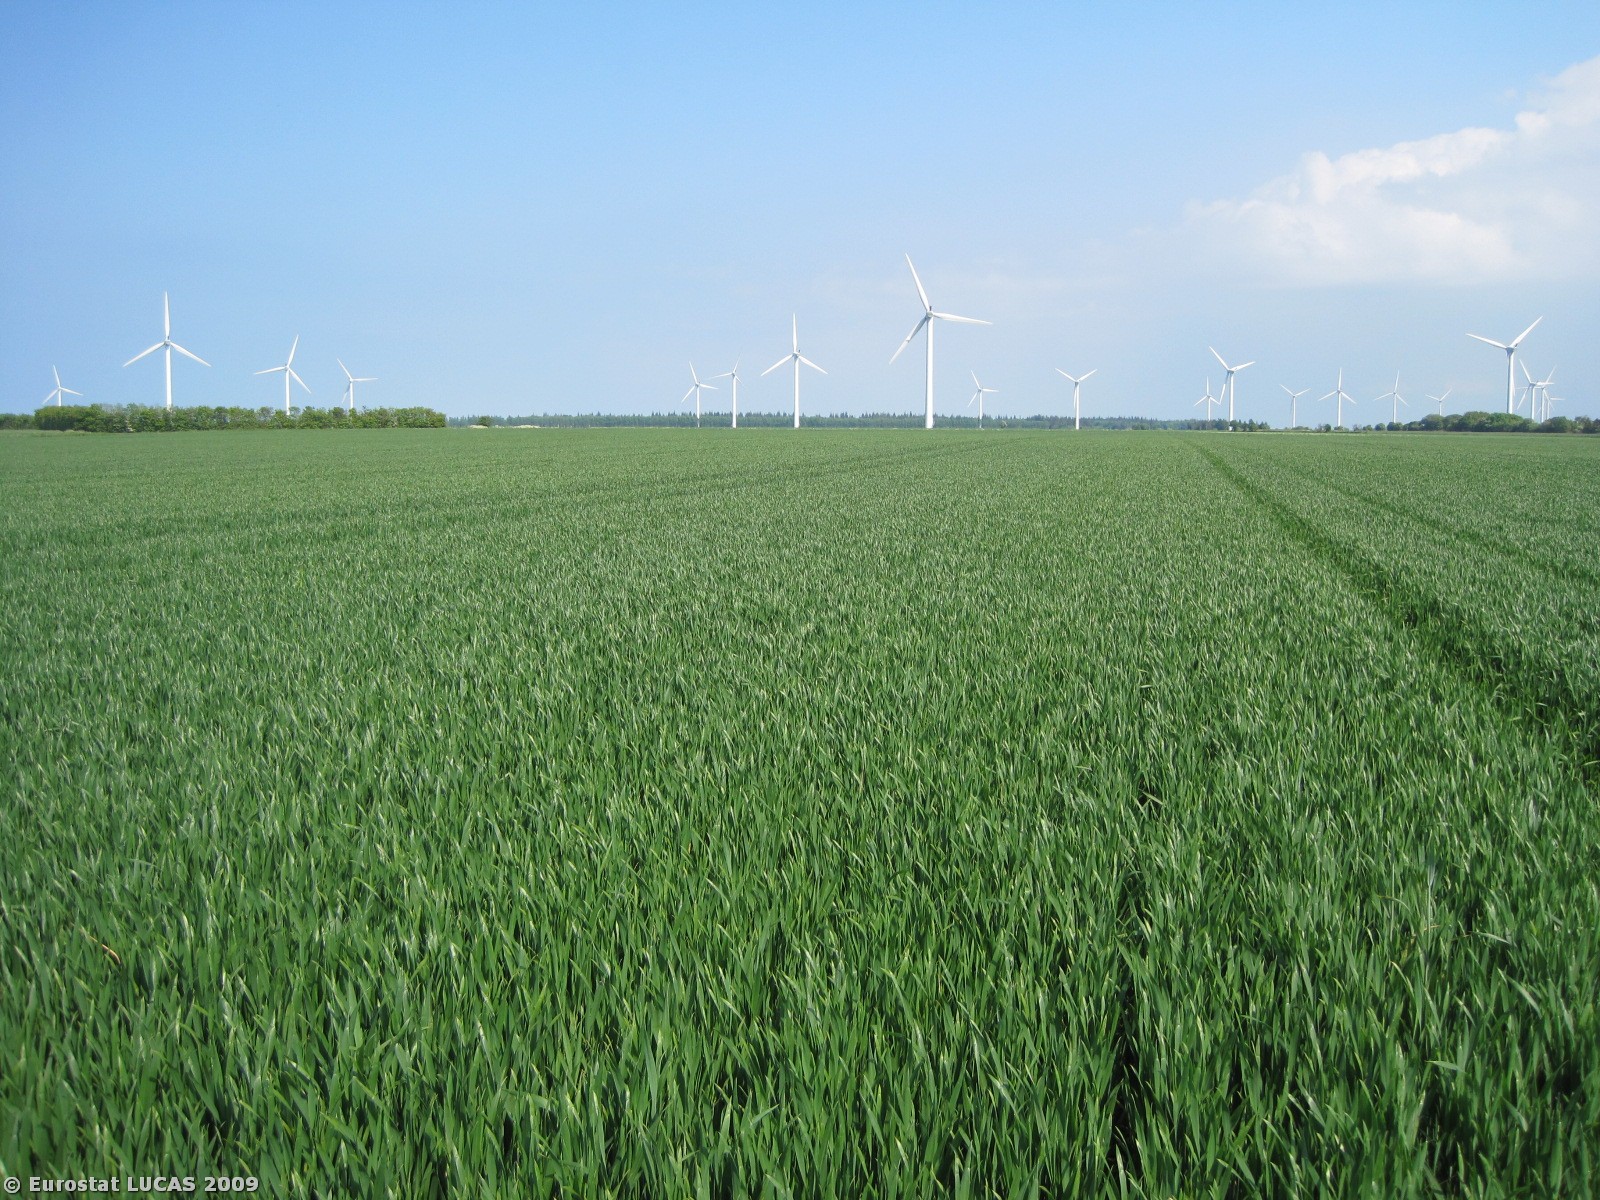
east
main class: Cropland
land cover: Common wheat
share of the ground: > 75 %
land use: Agriculture (excluding fallow land and kitchen gardens)
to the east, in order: Common wheat
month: May
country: DK
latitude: 56.6728
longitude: 10.2770
